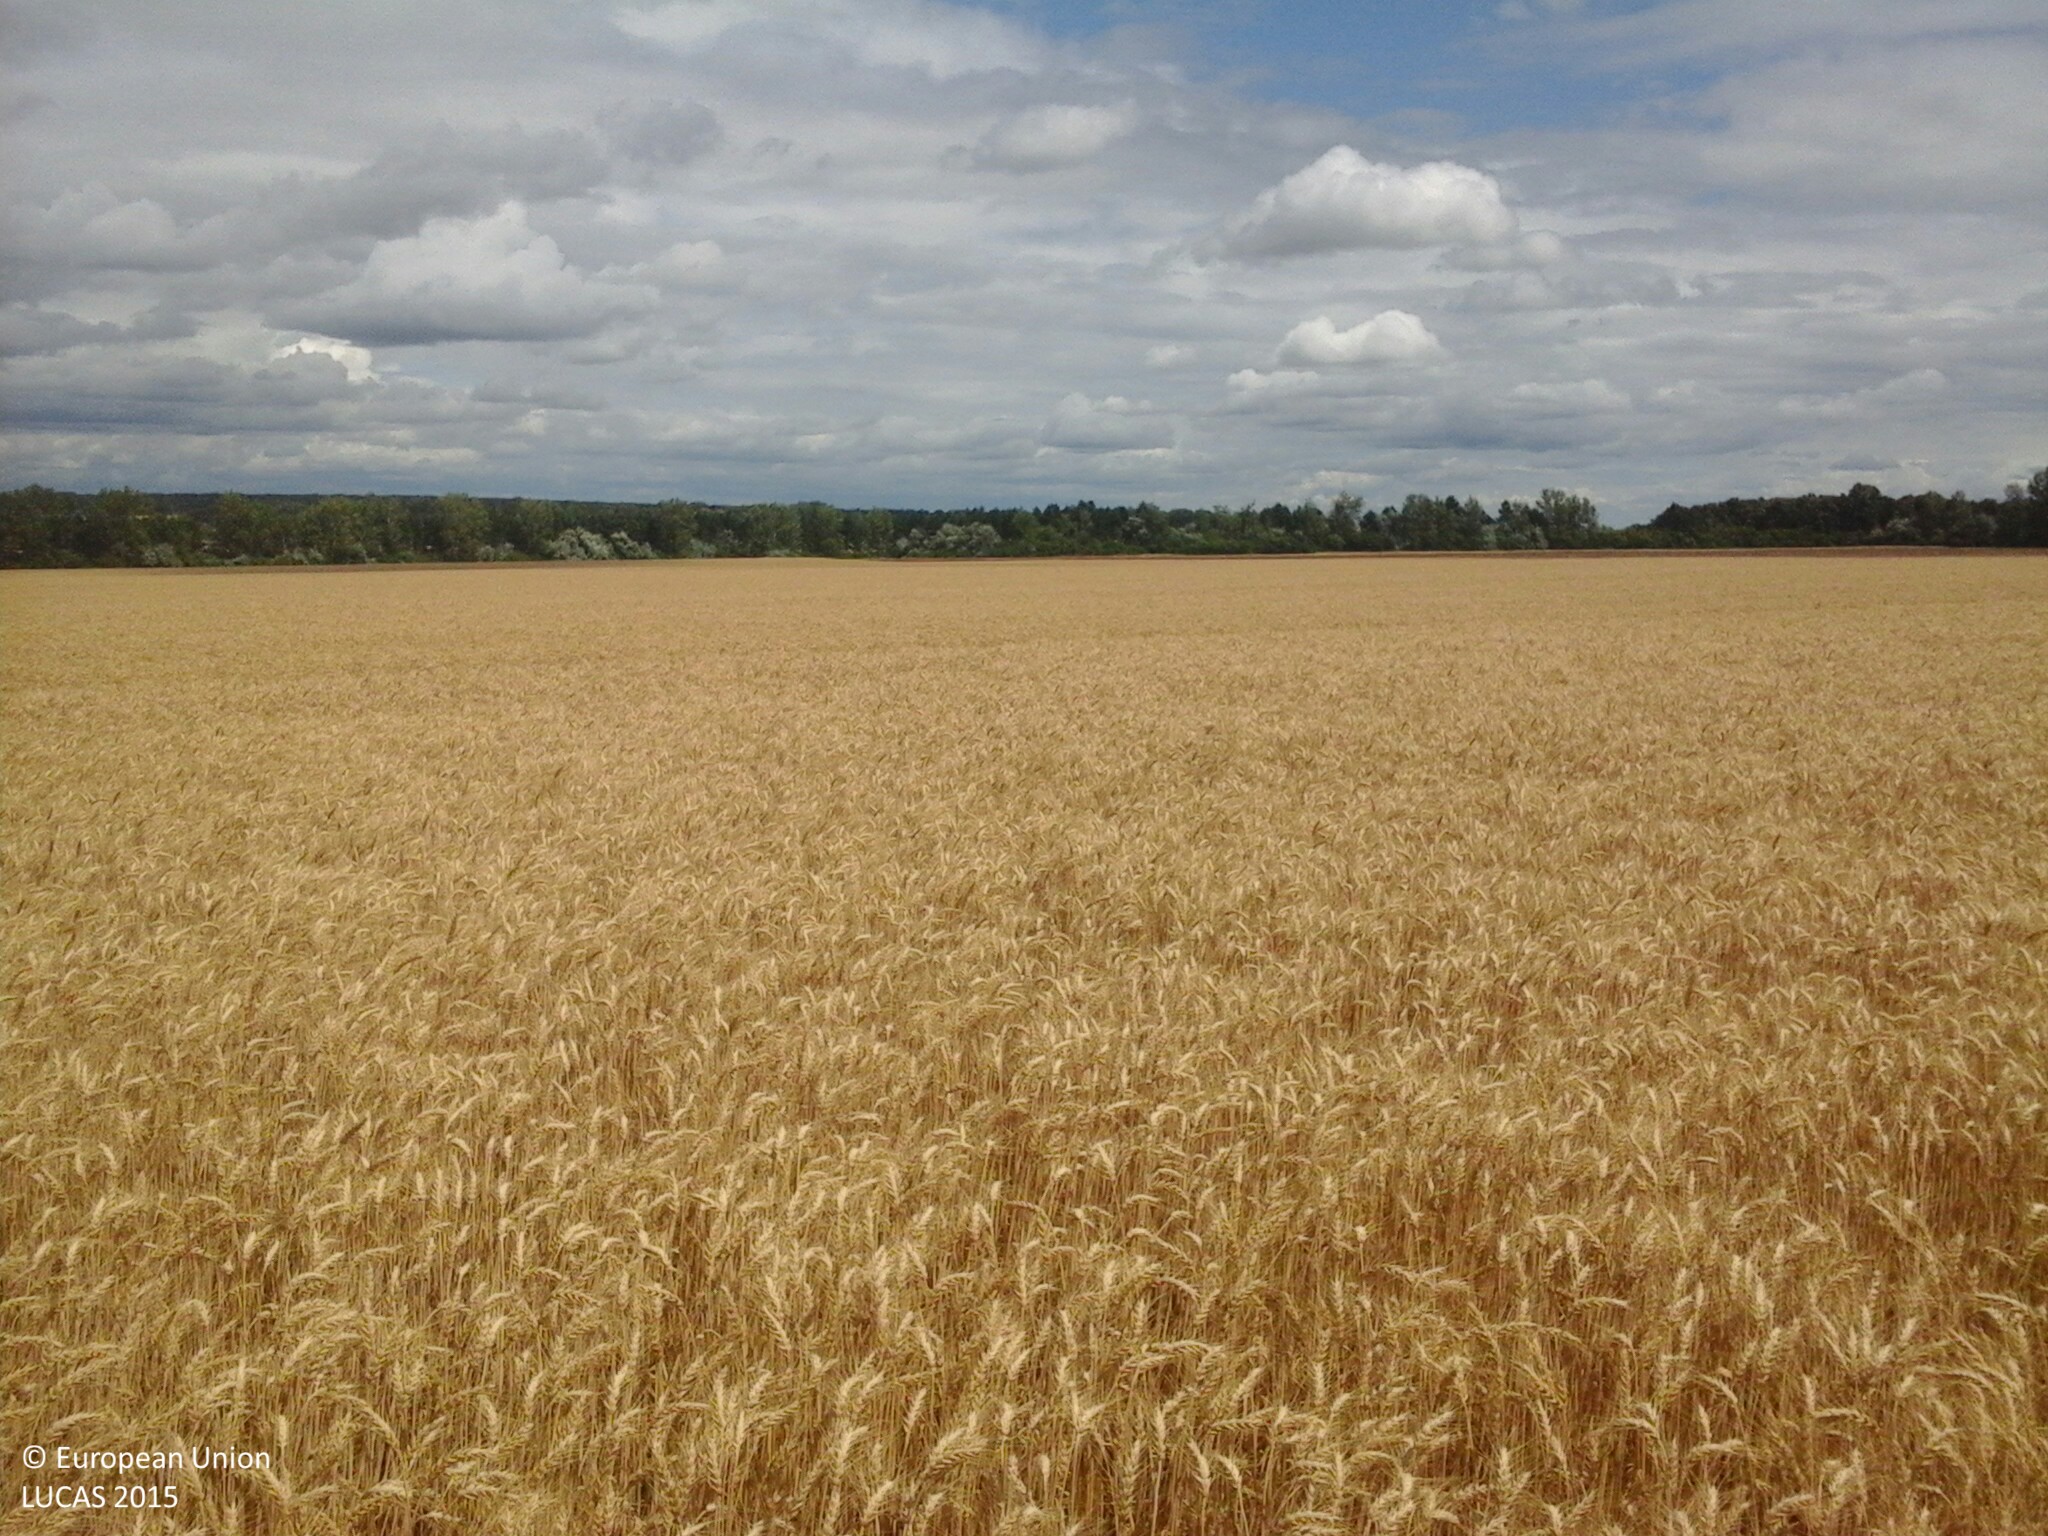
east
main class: Cropland
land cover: Durum wheat
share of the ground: > 75 %
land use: Agriculture (excluding fallow land and kitchen gardens)
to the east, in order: Durum wheat
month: July
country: HU
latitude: 47.0861
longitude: 17.9520
